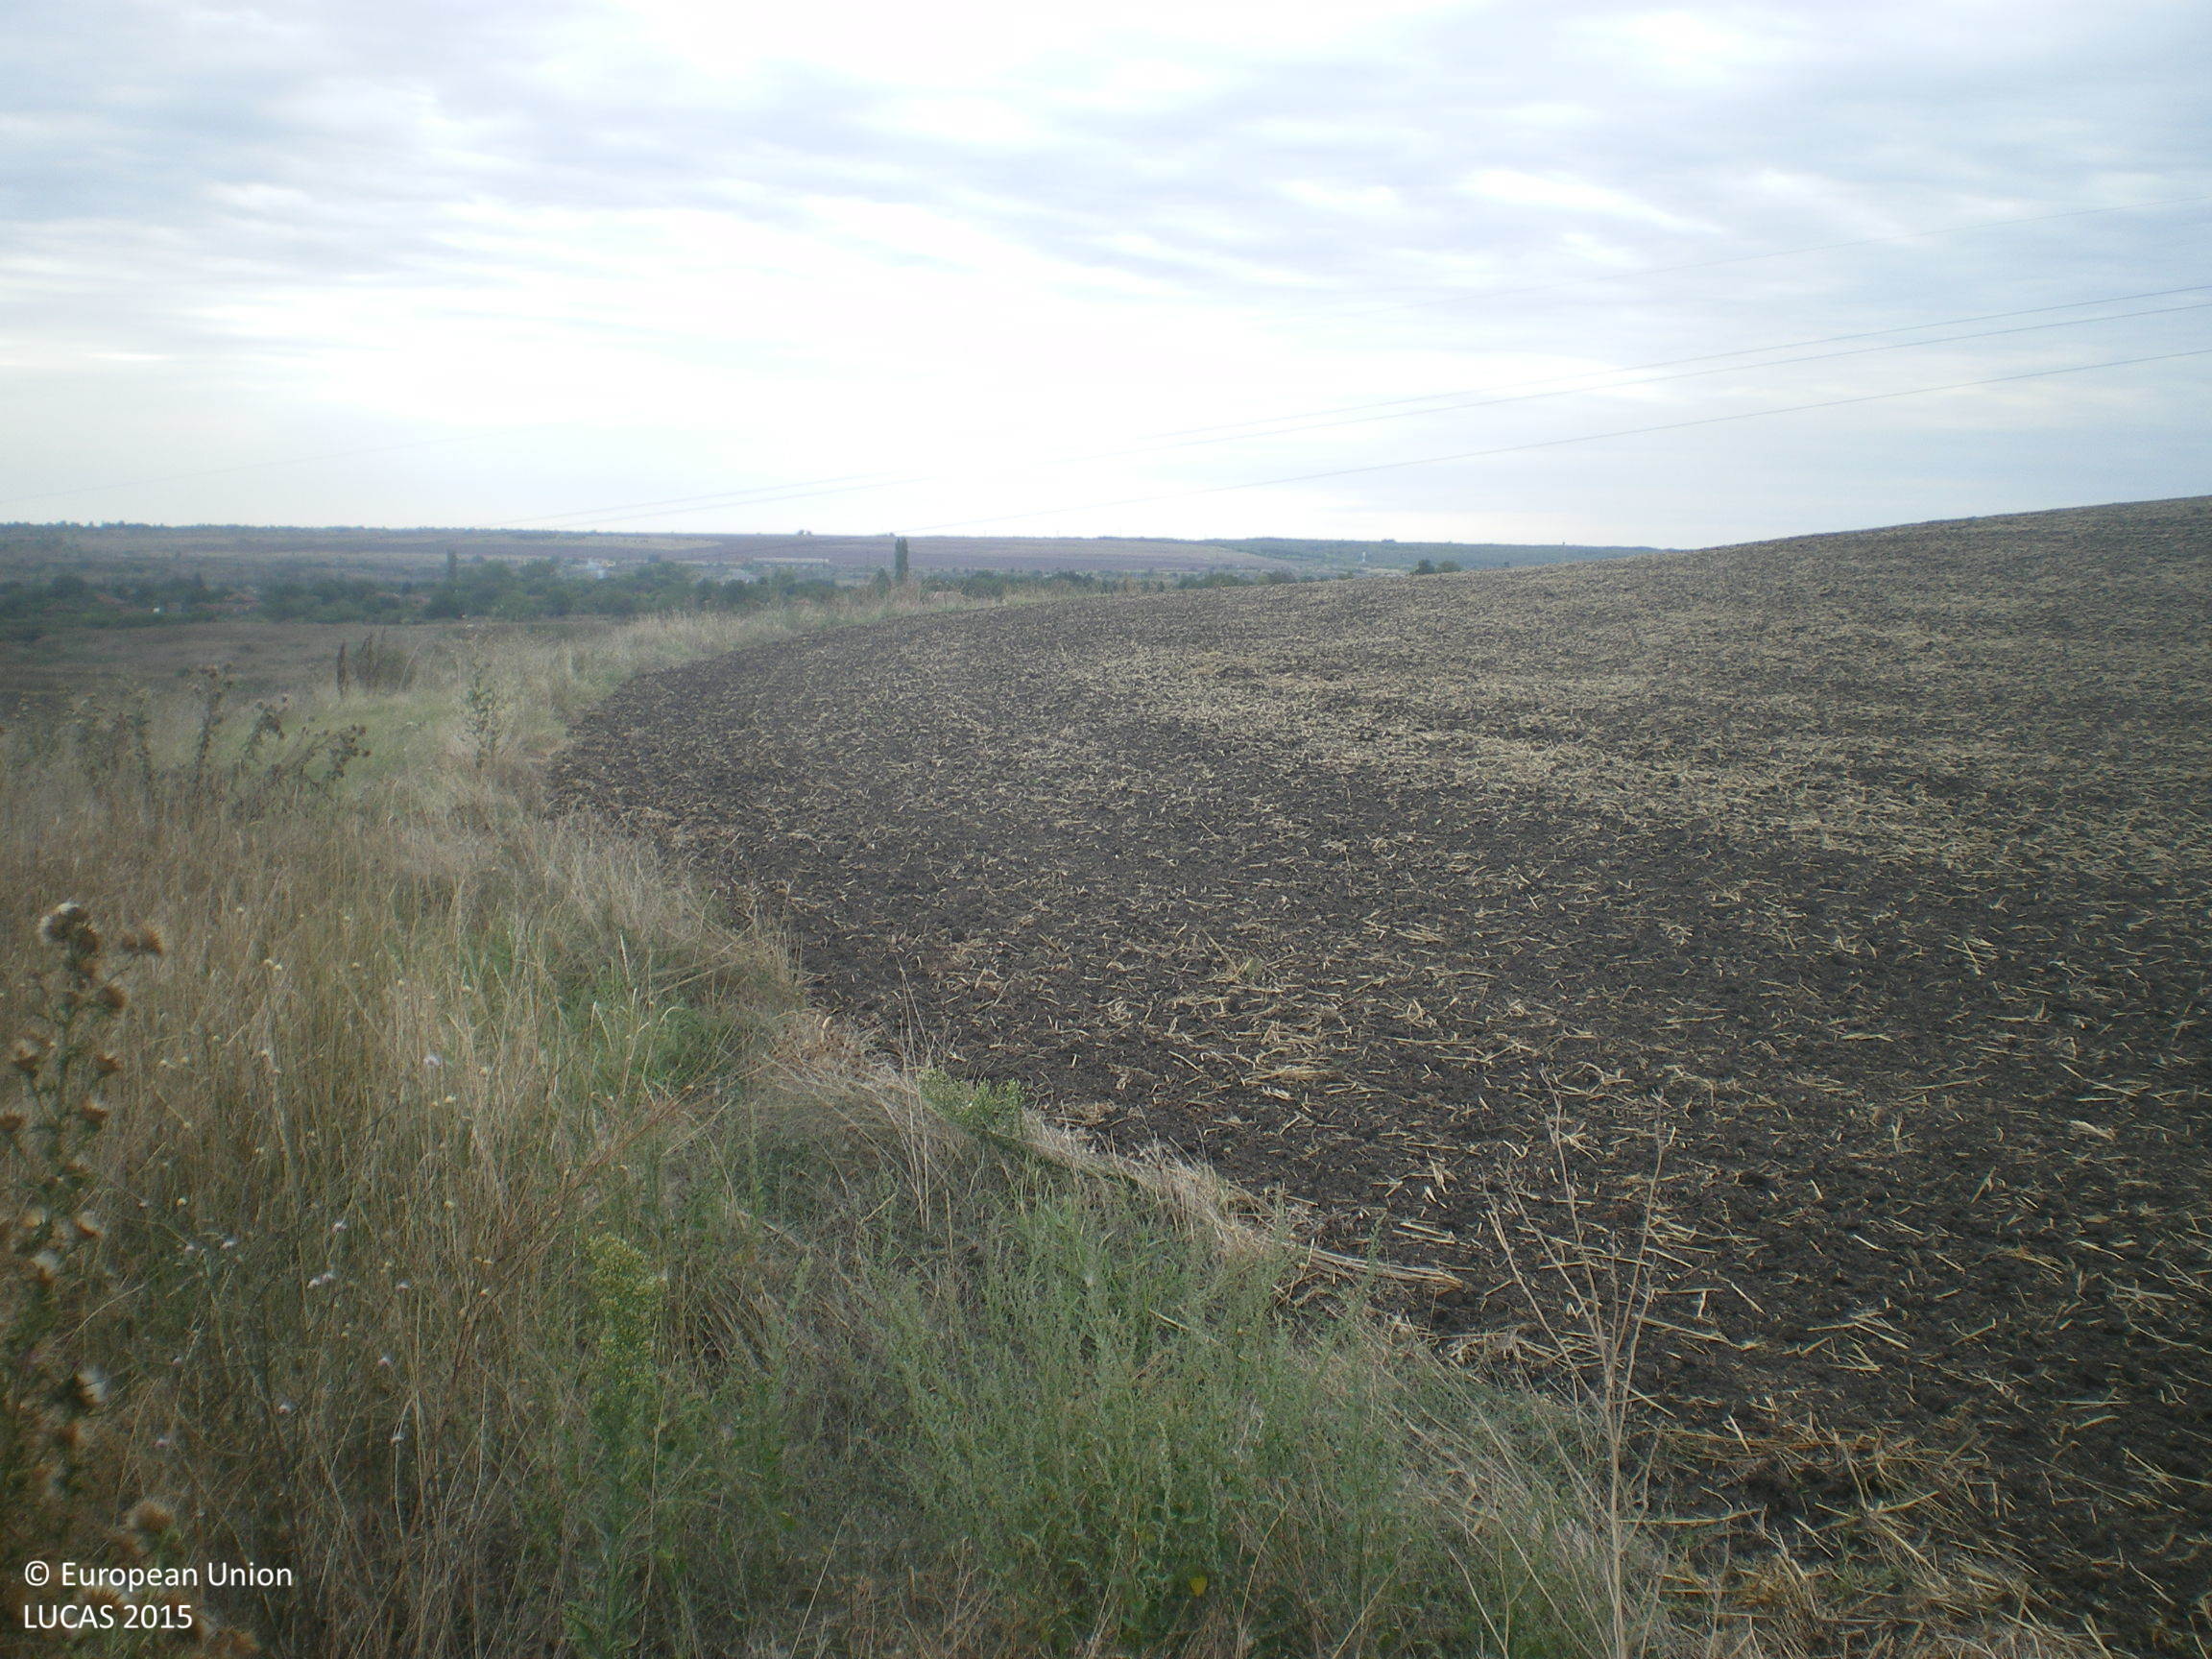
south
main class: Grassland
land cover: Grassland without tree/shrub cover
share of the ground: > 75 %
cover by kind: herbaceous plants 100 %
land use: Agriculture (excluding fallow land and kitchen gardens)
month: September
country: BG
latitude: 42.2066
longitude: 25.9550
